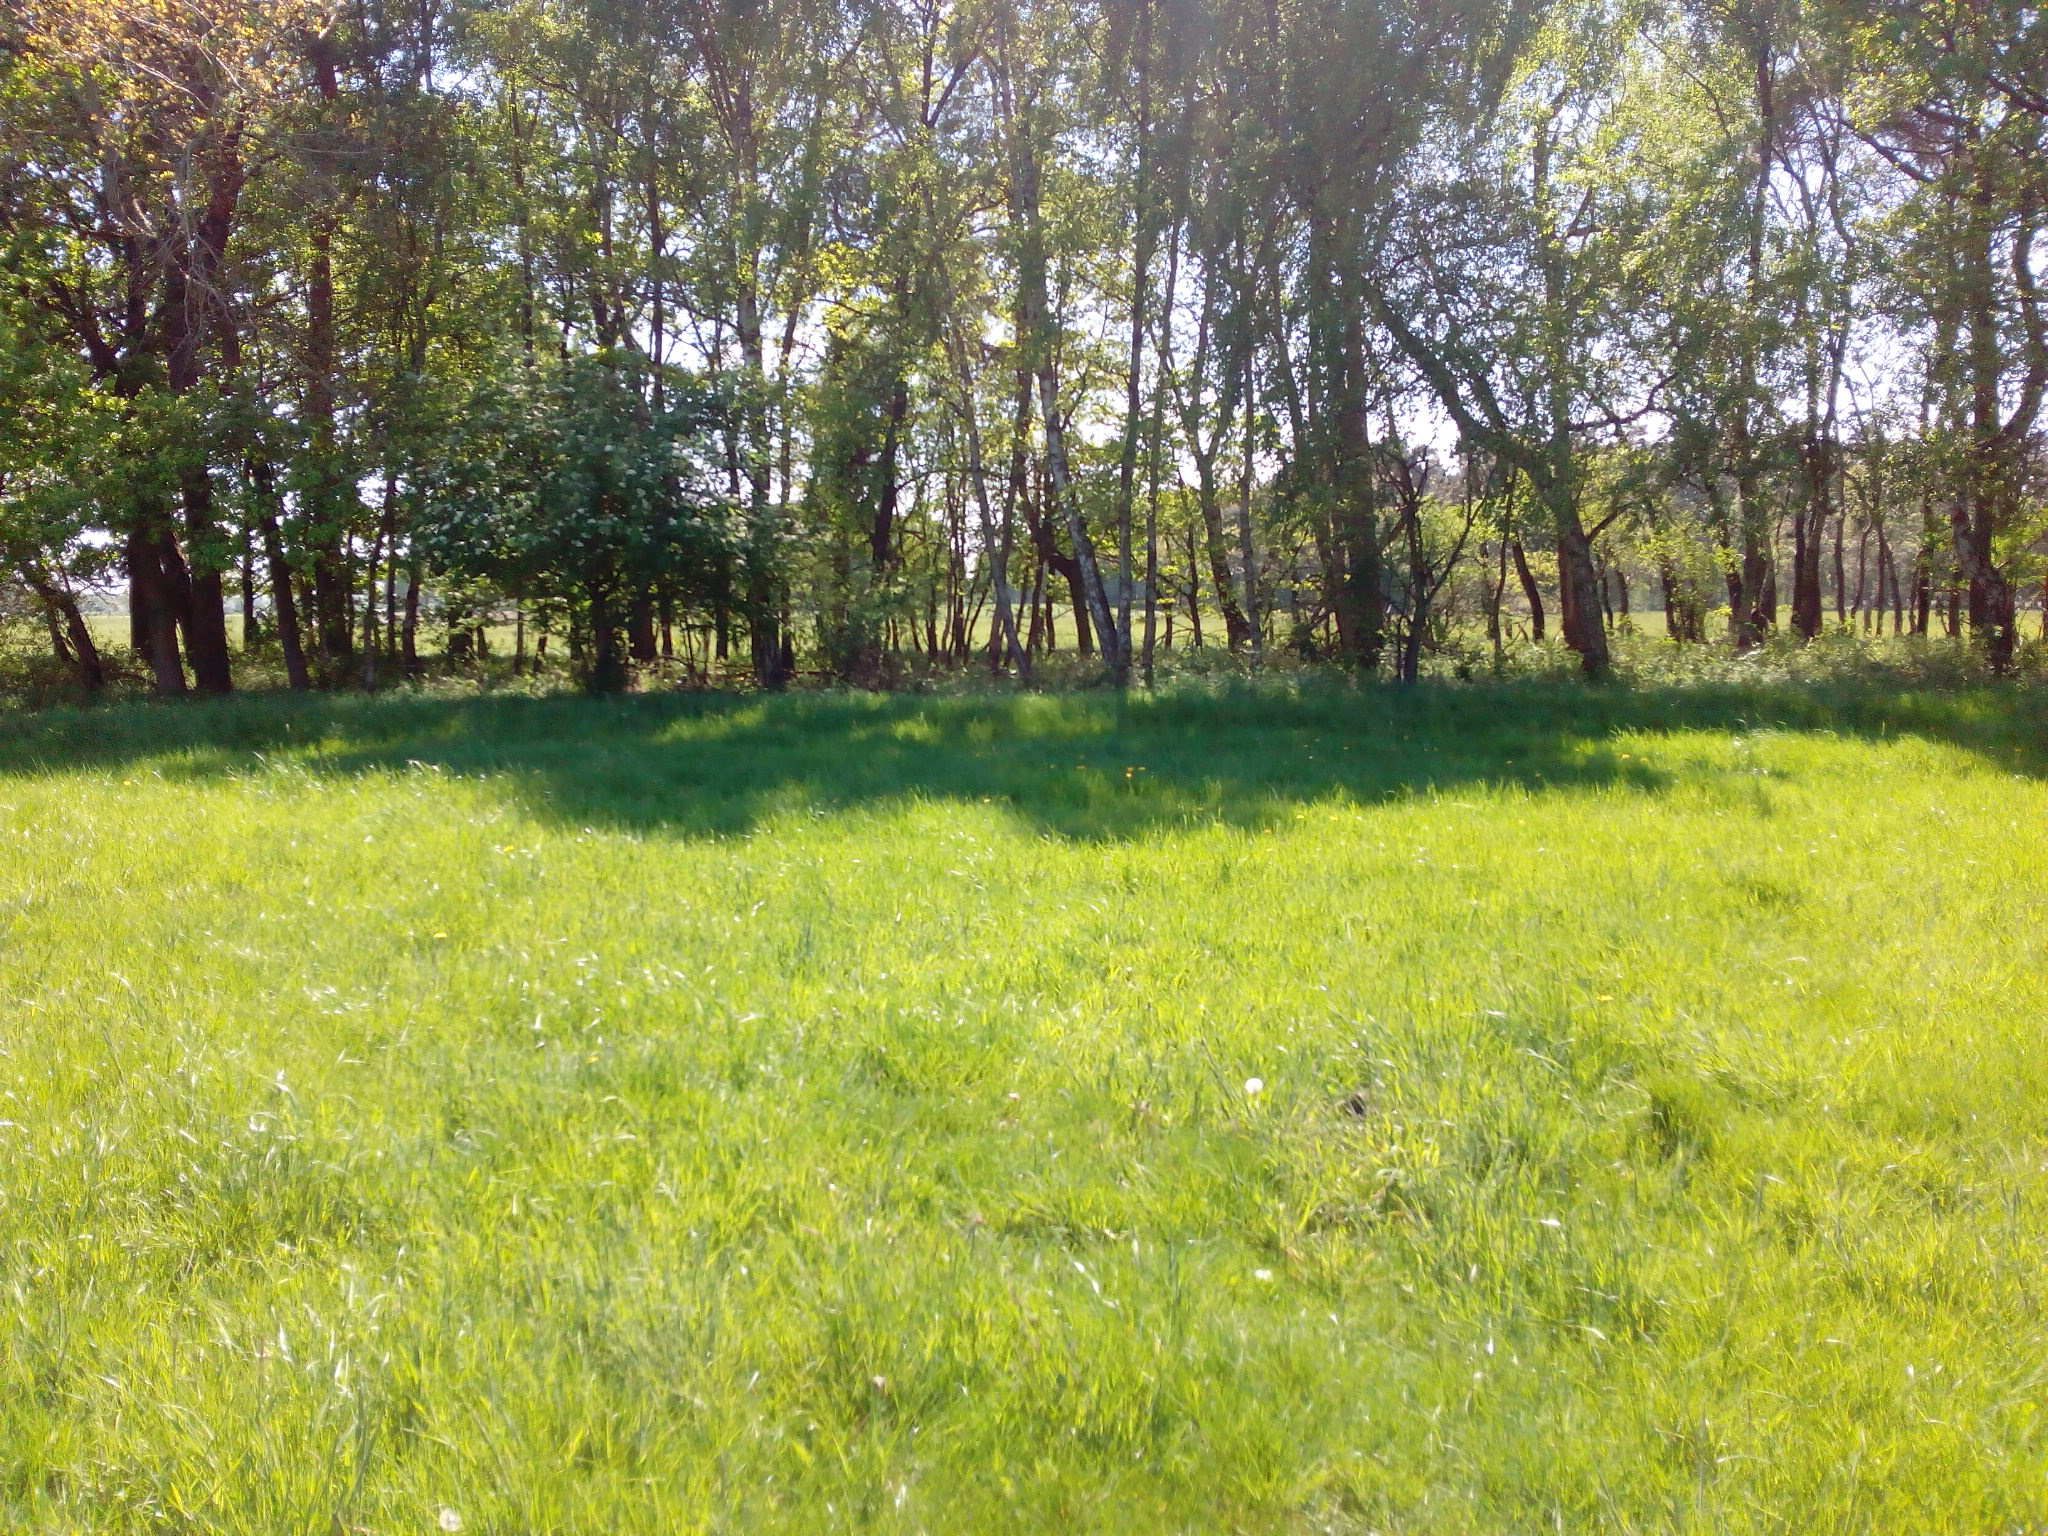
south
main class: Grassland
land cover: Grassland without tree/shrub cover
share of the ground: > 75 %
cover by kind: herbaceous plants 100 %
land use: Agriculture (excluding fallow land and kitchen gardens)
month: May
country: DE
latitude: 52.4846
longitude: 9.6026
